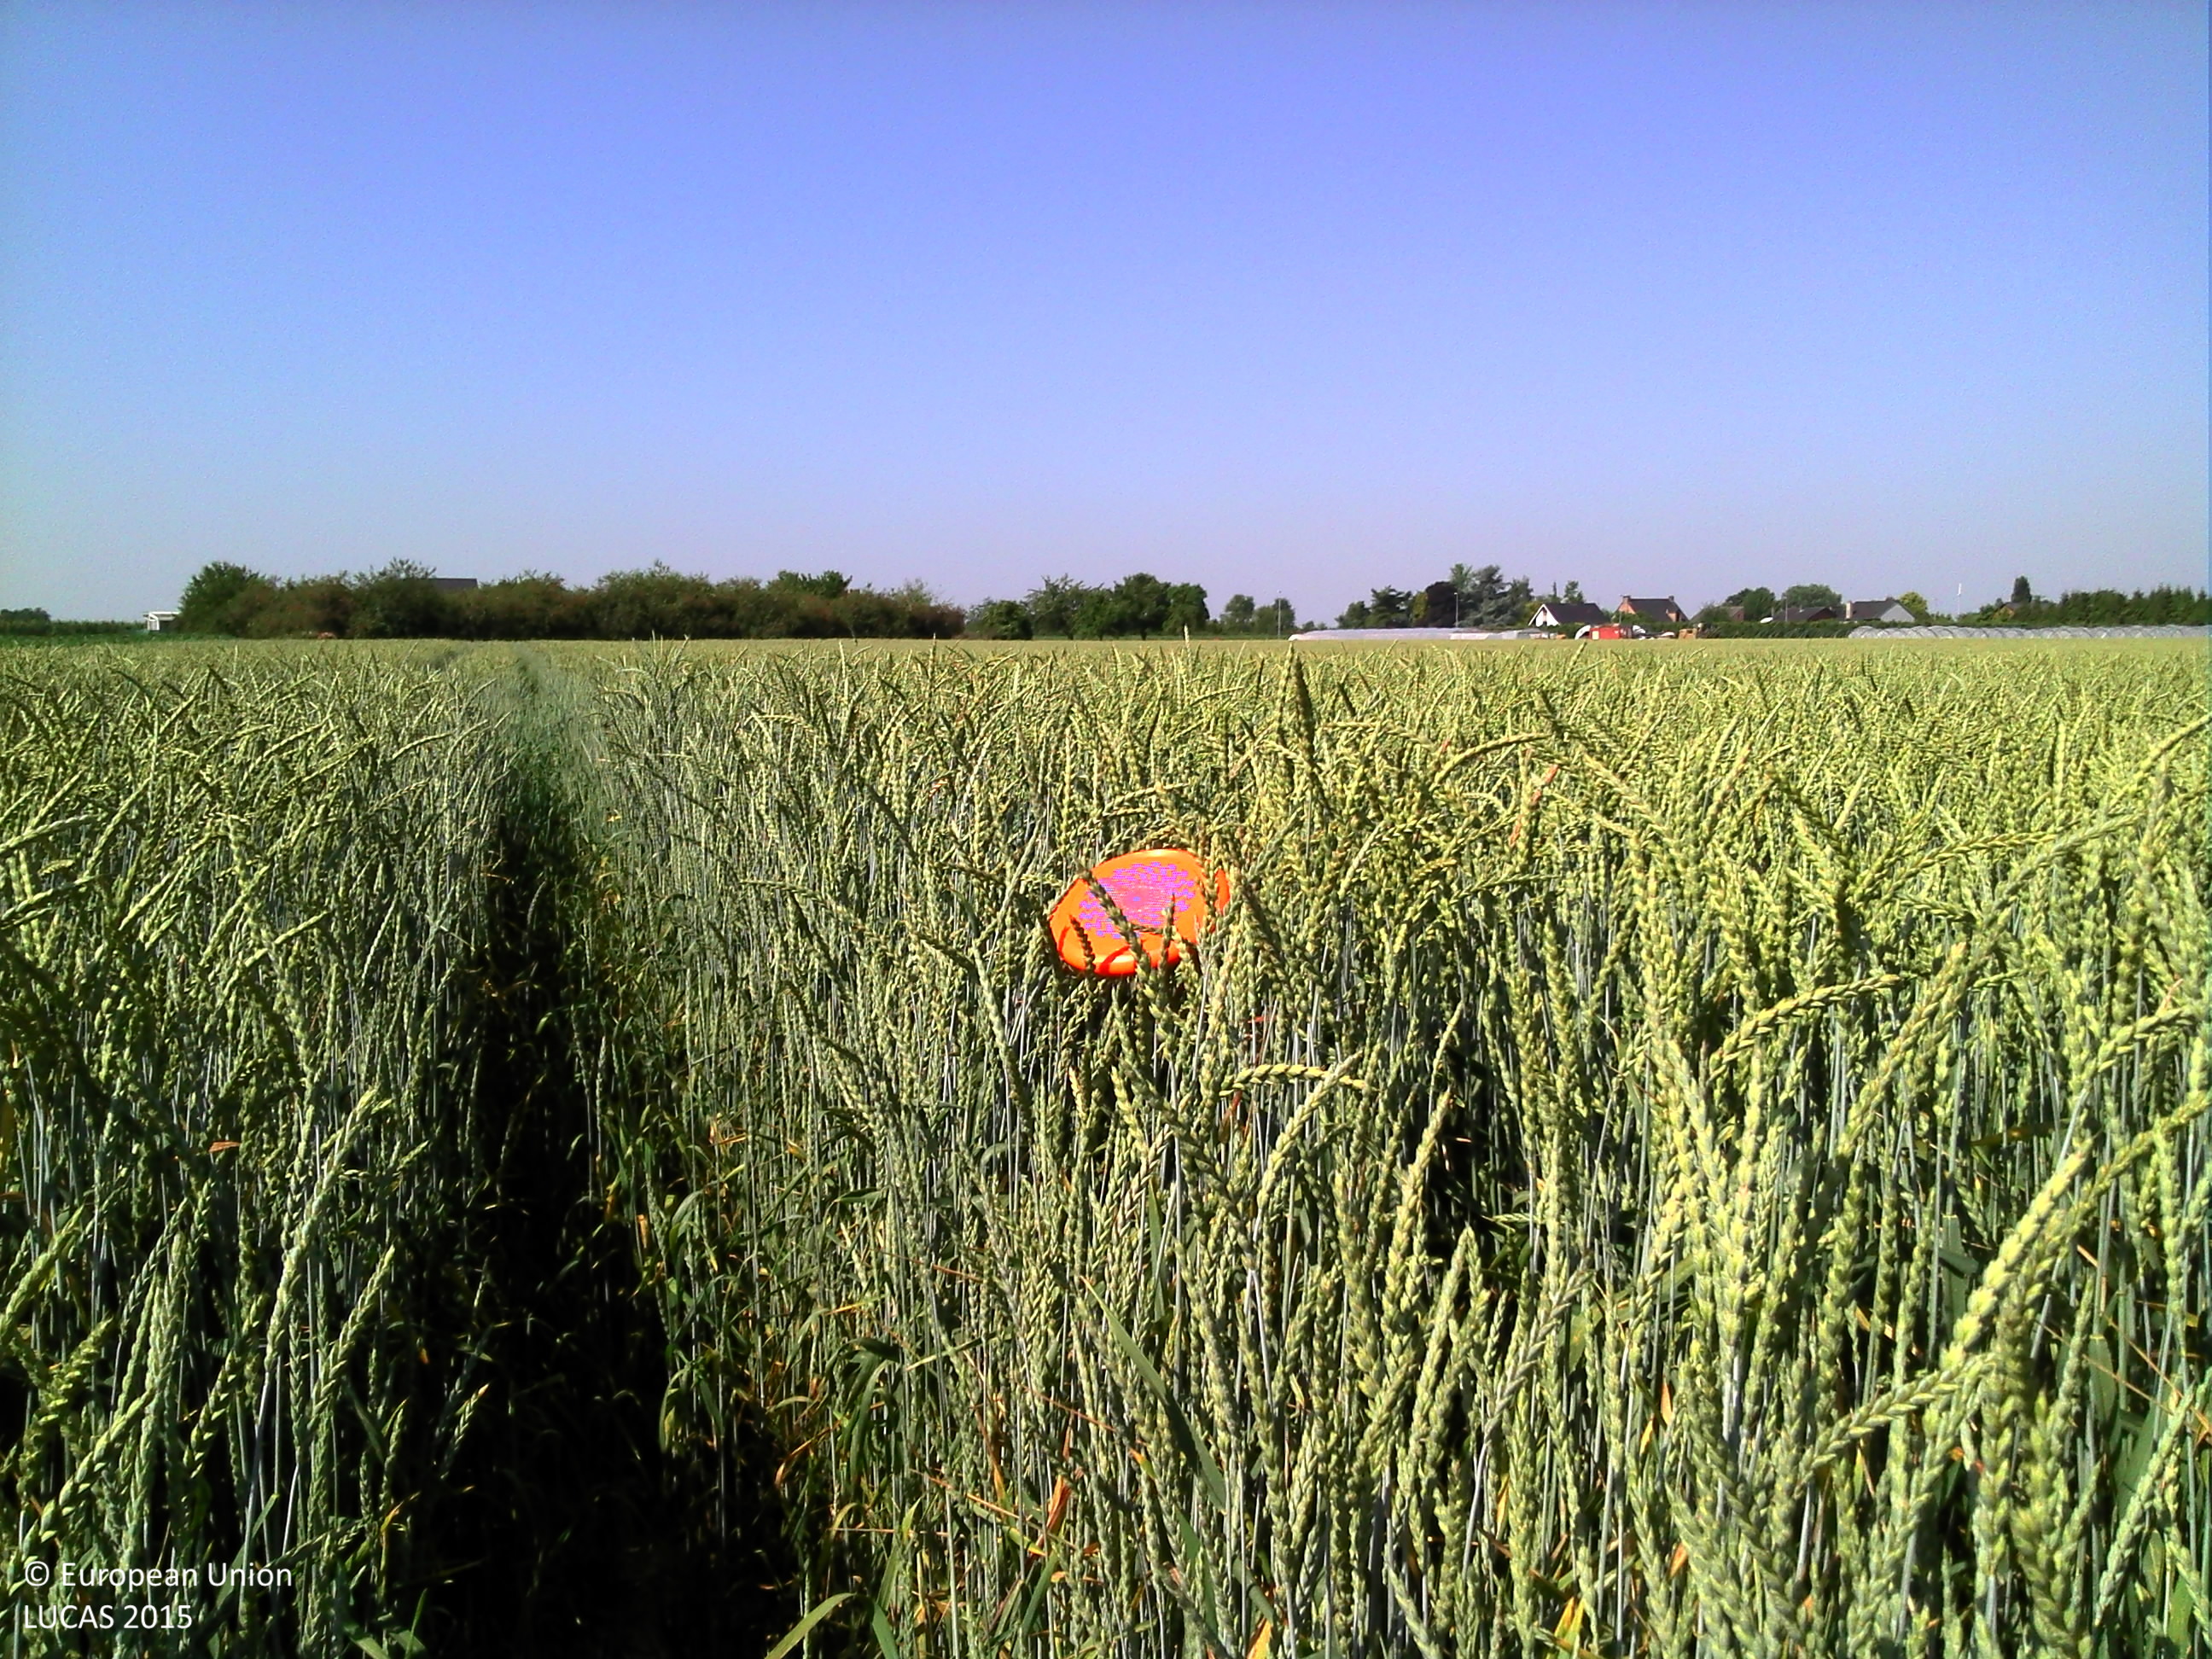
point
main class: Cropland
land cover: Common wheat
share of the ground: > 75 %
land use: Agriculture (excluding fallow land and kitchen gardens)
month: June
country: BE
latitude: 50.8199
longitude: 5.1571
